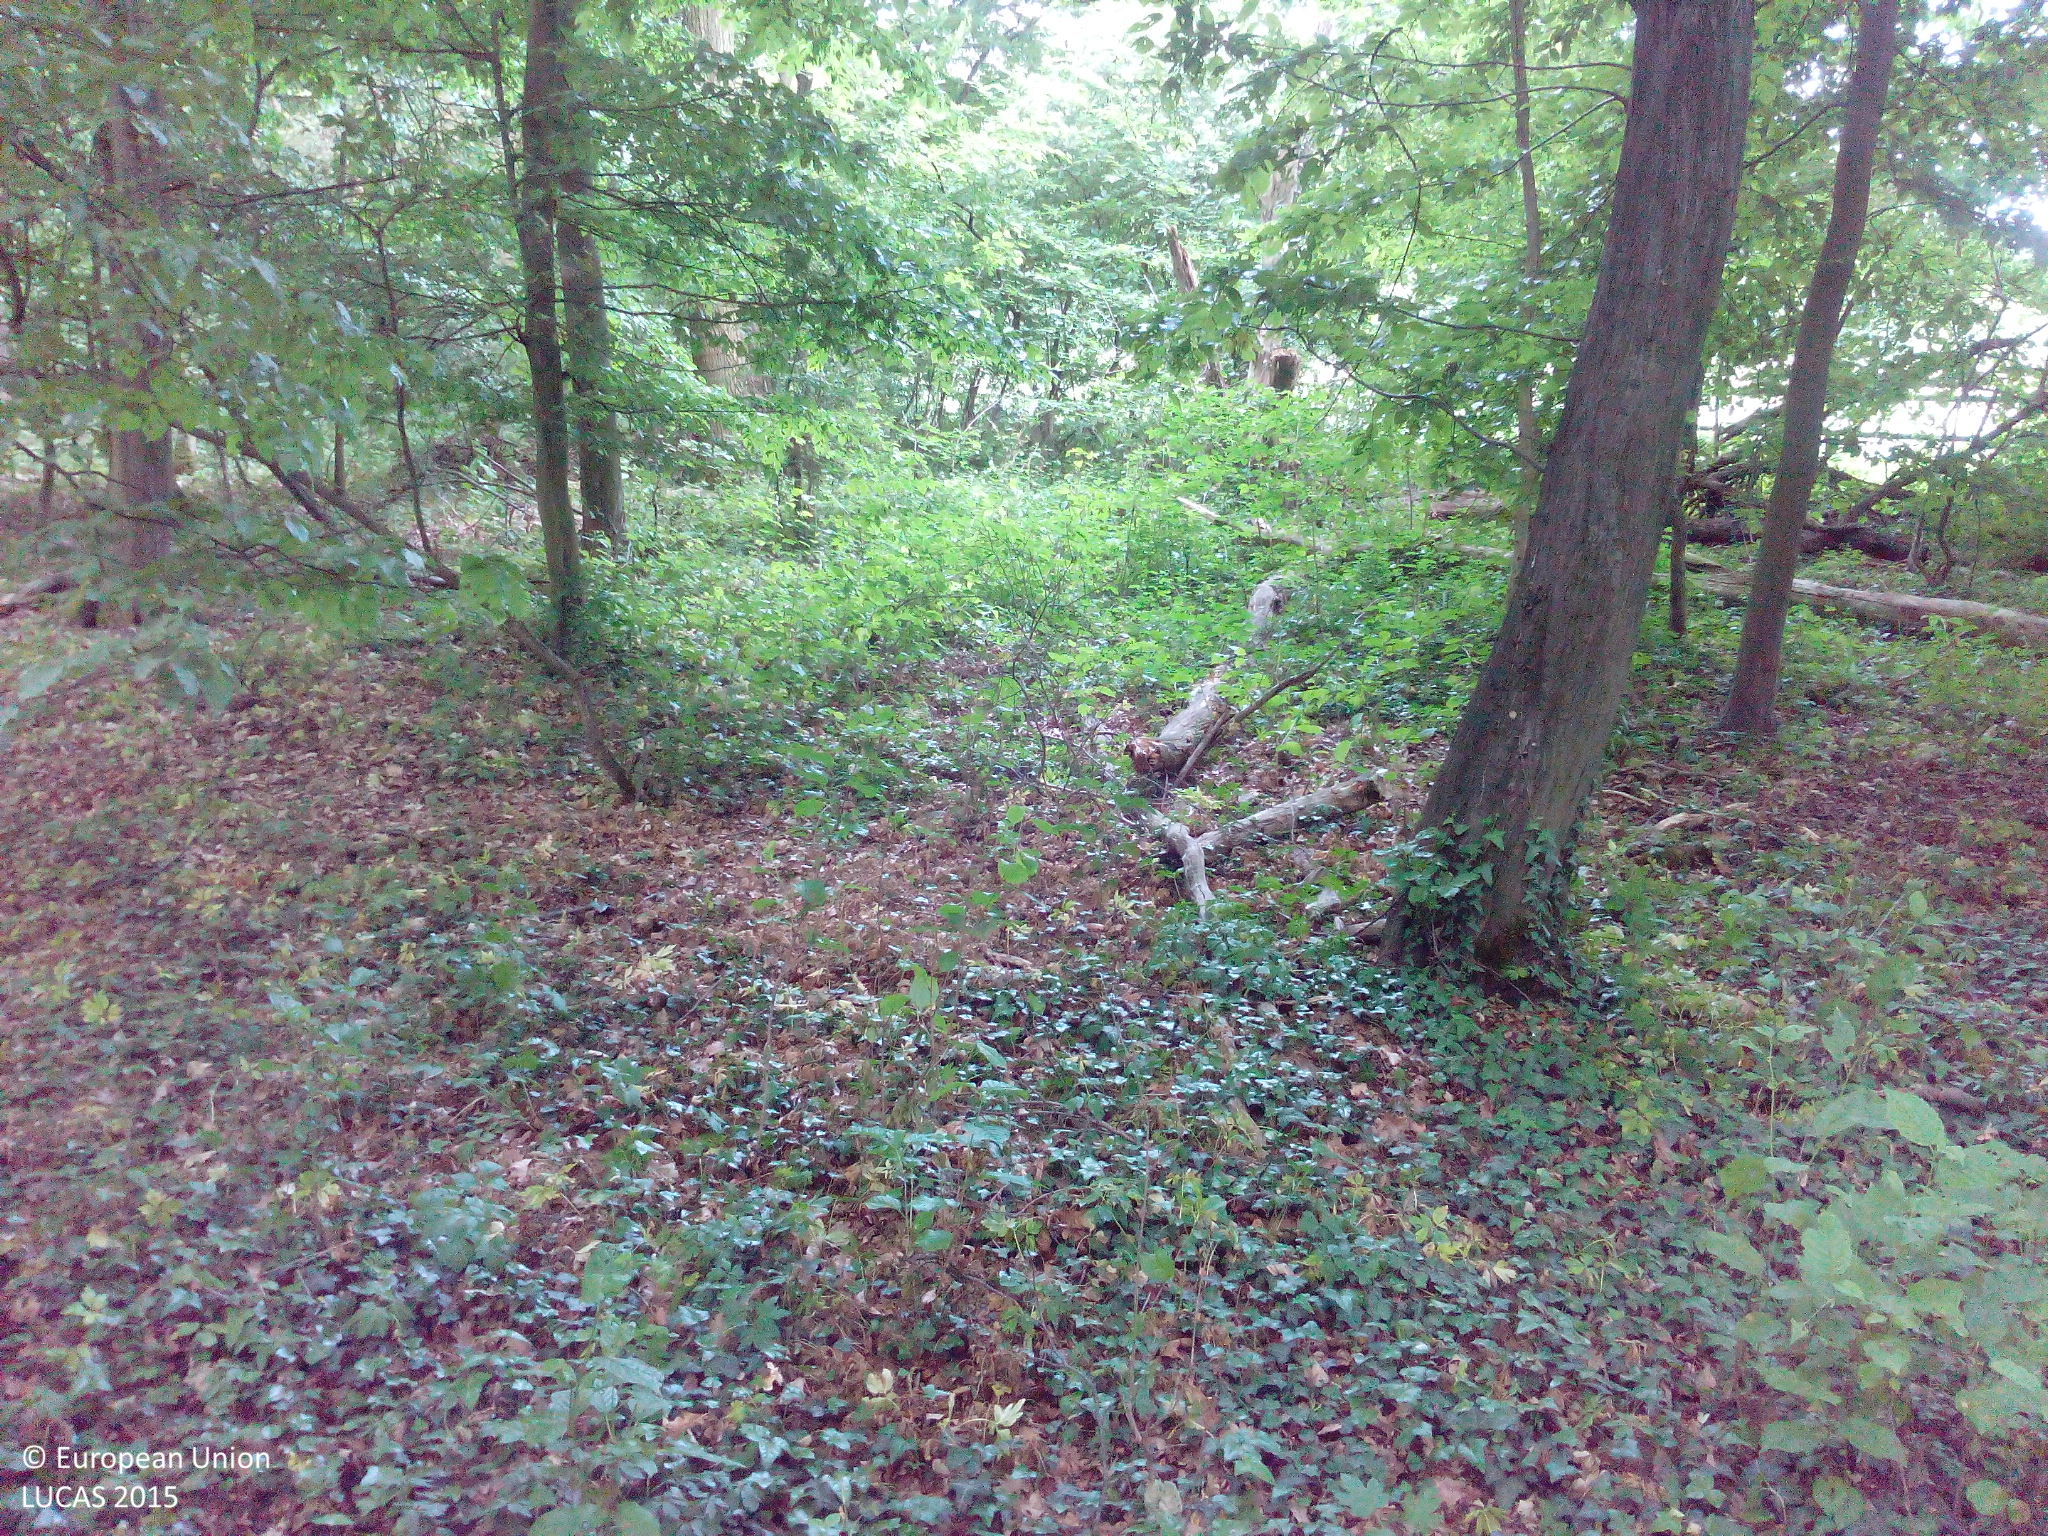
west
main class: Woodland
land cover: Broadleaved woodland
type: mesophytic deciduous forest
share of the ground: > 75 %
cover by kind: broadleaved forest trees 80 %, herbaceous plants 10 %, shrubs 5 %, unconsolidated bare surface 5 %
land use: Forestry
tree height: > 5 m
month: May
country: DE
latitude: 49.9515
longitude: 8.0353
